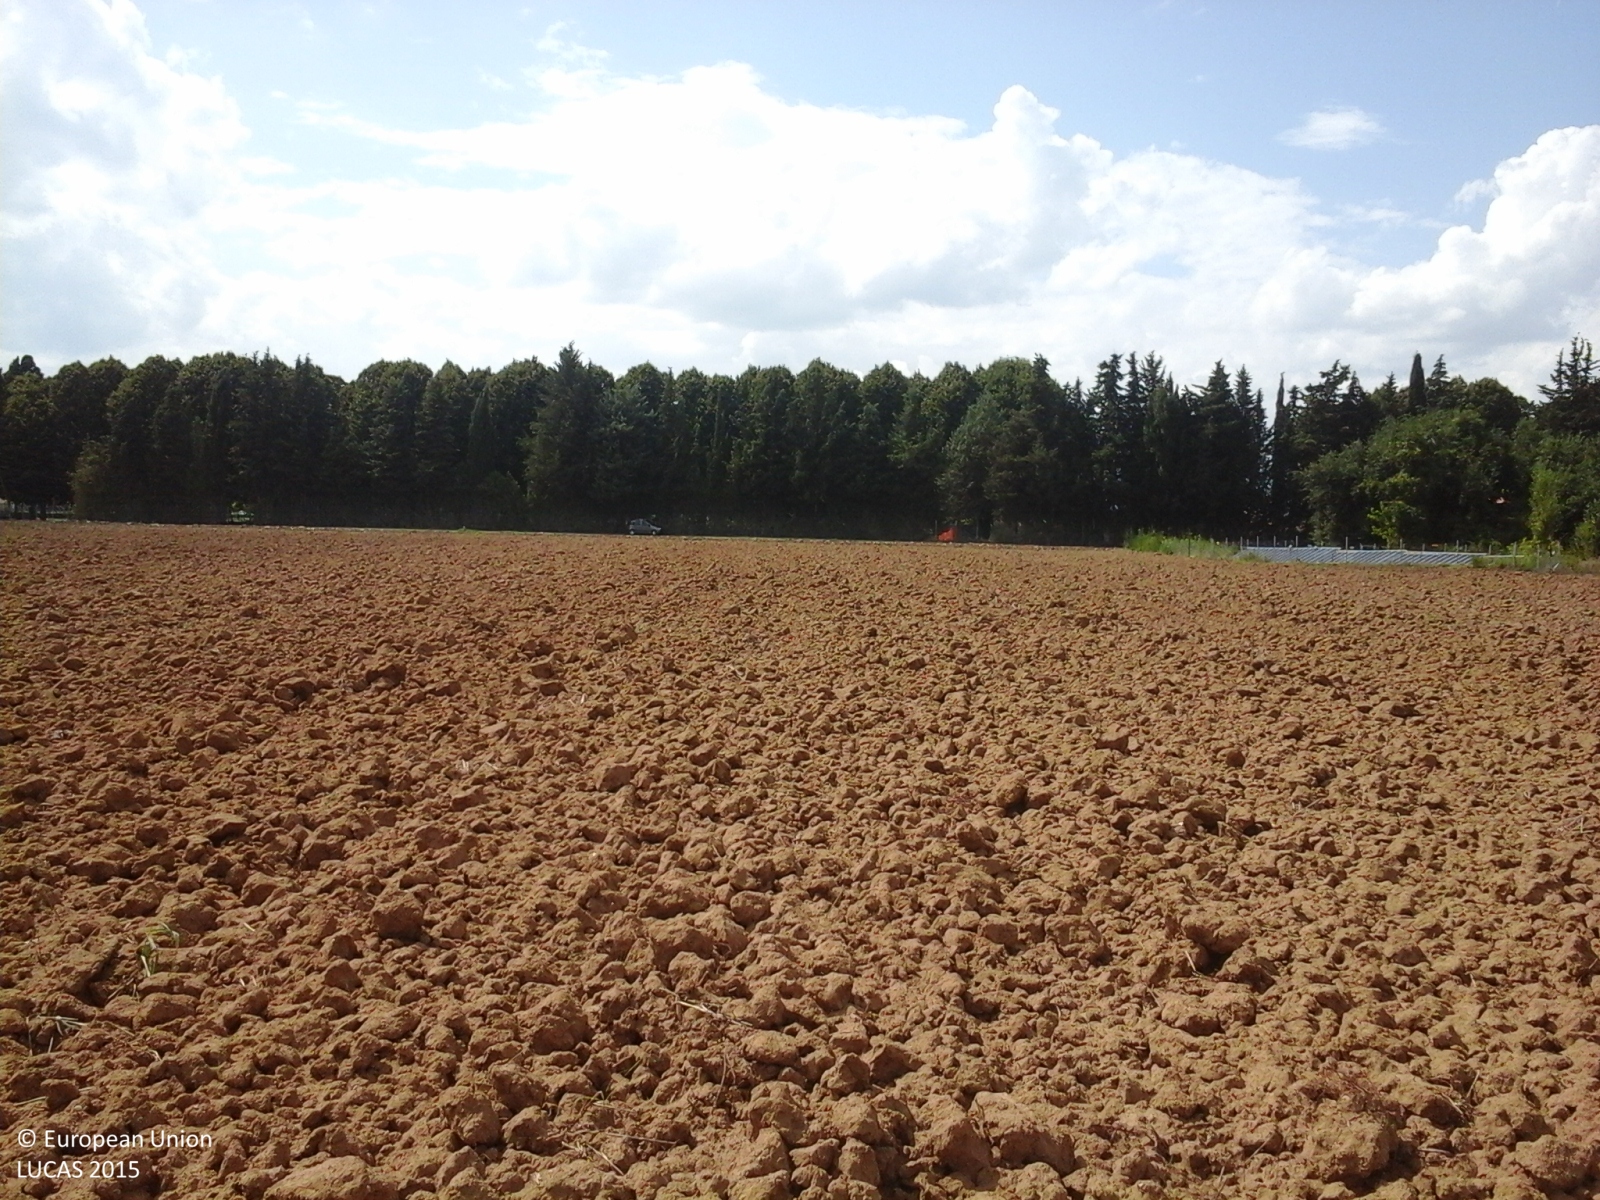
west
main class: Cropland
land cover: Durum wheat
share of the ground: < 10 %
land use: Agriculture (excluding fallow land and kitchen gardens)
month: August
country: IT
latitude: 43.4897
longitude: 13.1700
